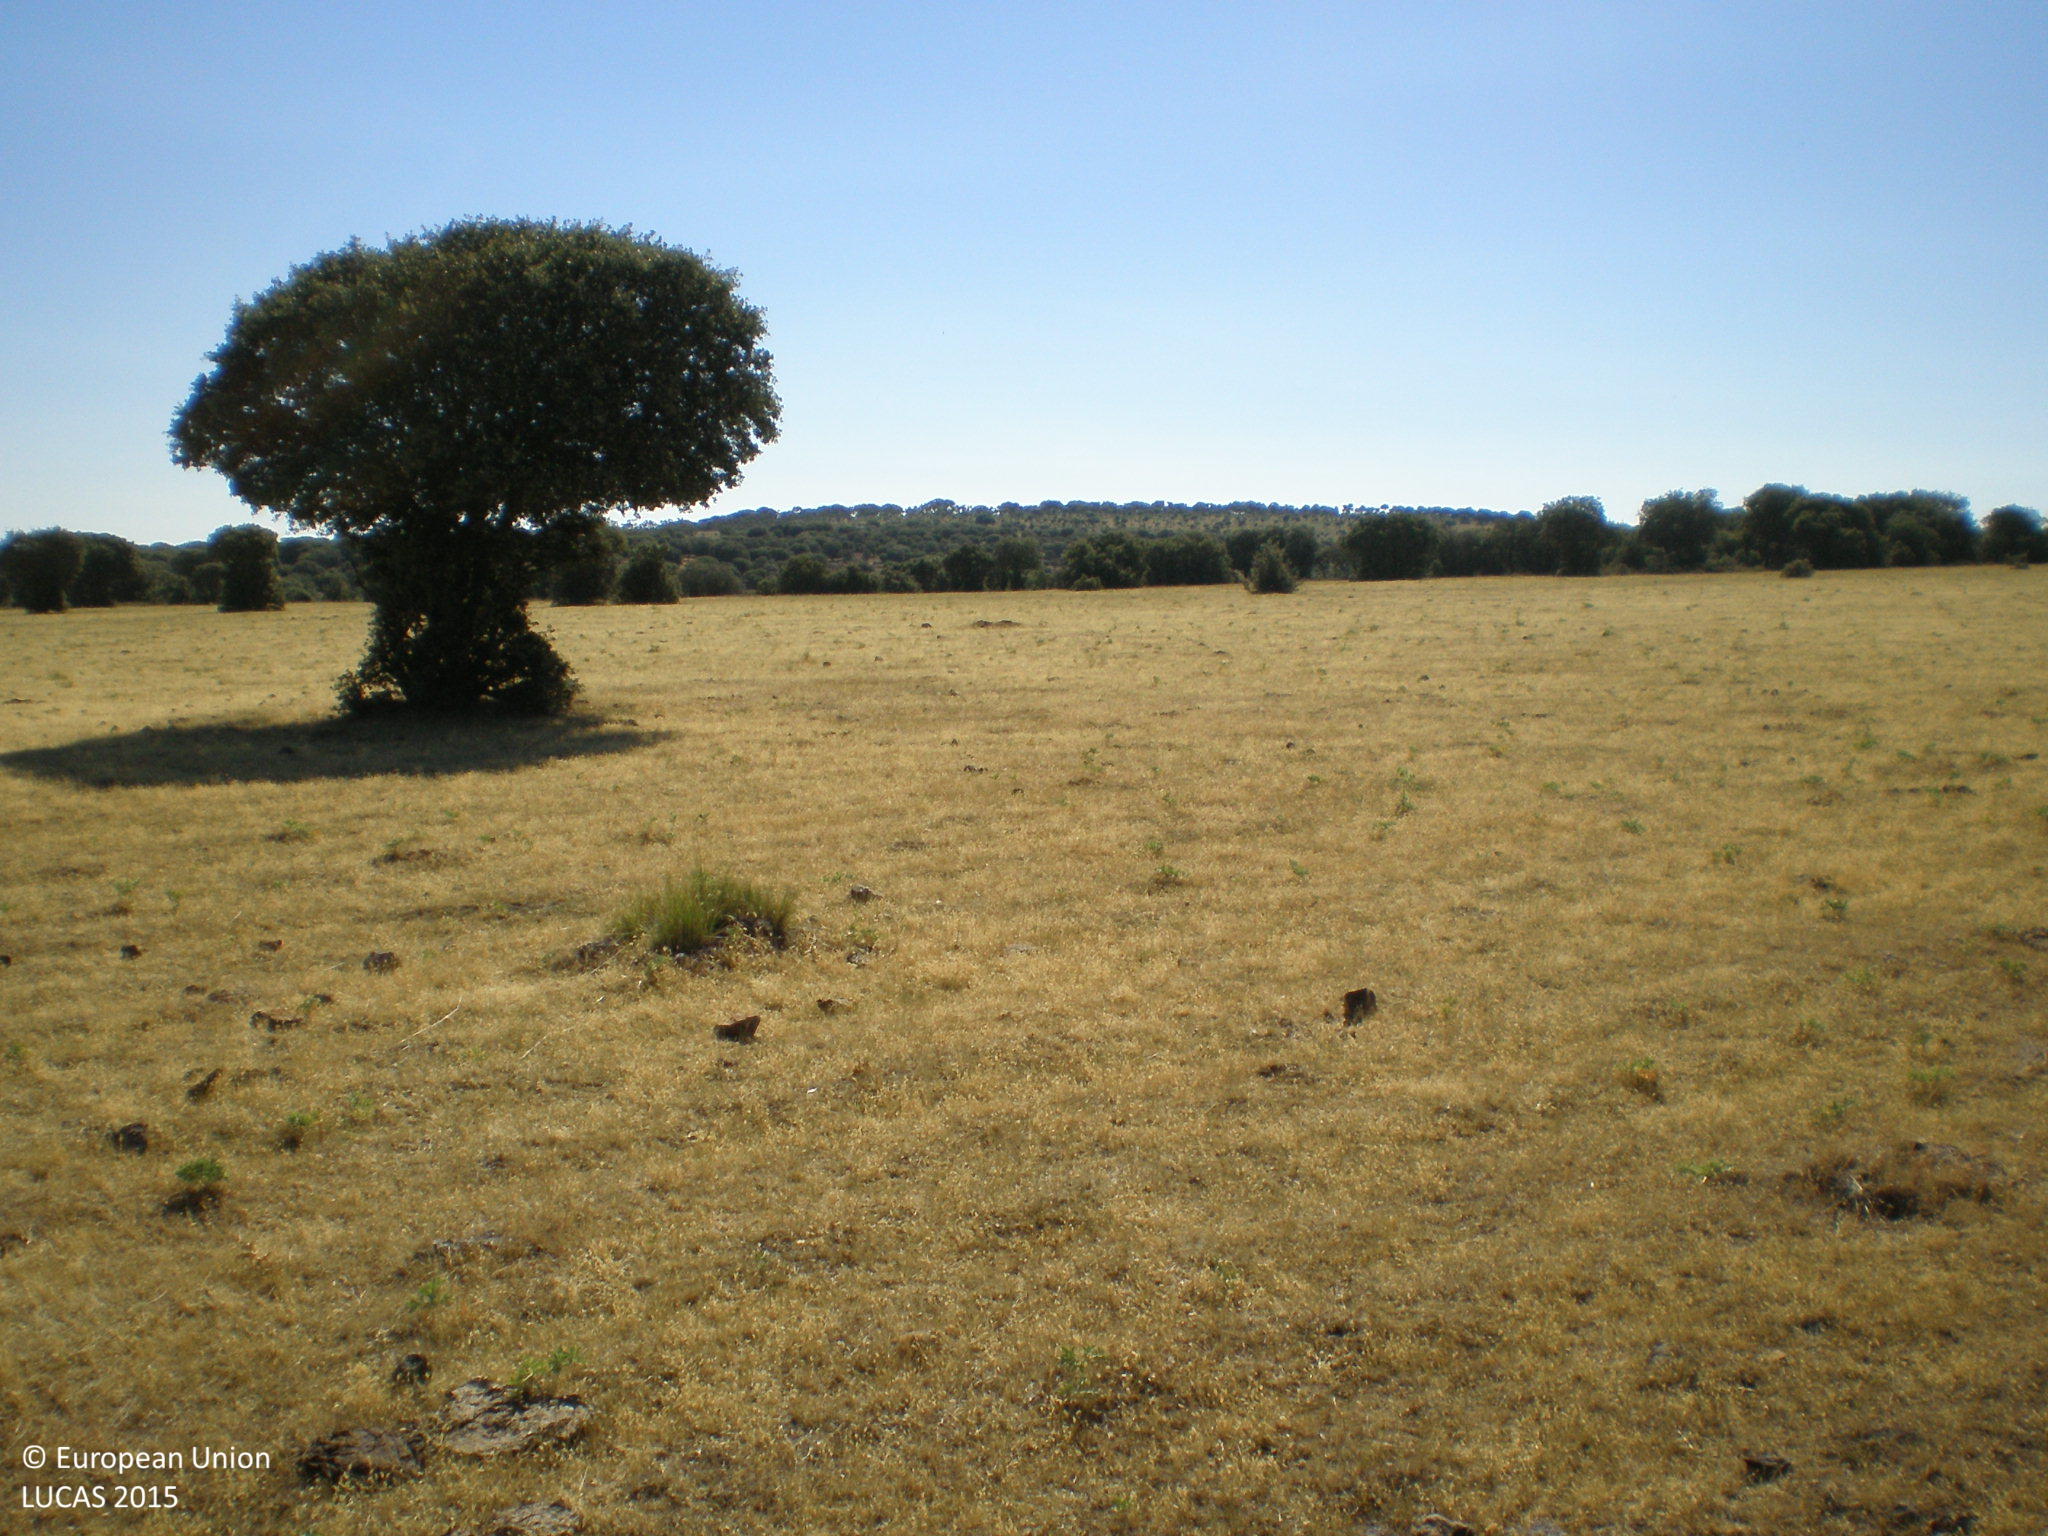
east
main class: Grassland
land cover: Grassland with sparse tree/shrub cover
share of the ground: > 75 %
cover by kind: herbaceous plants 95 %, broadleaved forest trees 5 %
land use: Agriculture (excluding fallow land and kitchen gardens)
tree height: < 5 m
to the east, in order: Grassland with sparse tree/shrub cover; Broadleaved woodland
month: June
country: ES
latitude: 40.7986
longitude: -5.6850
